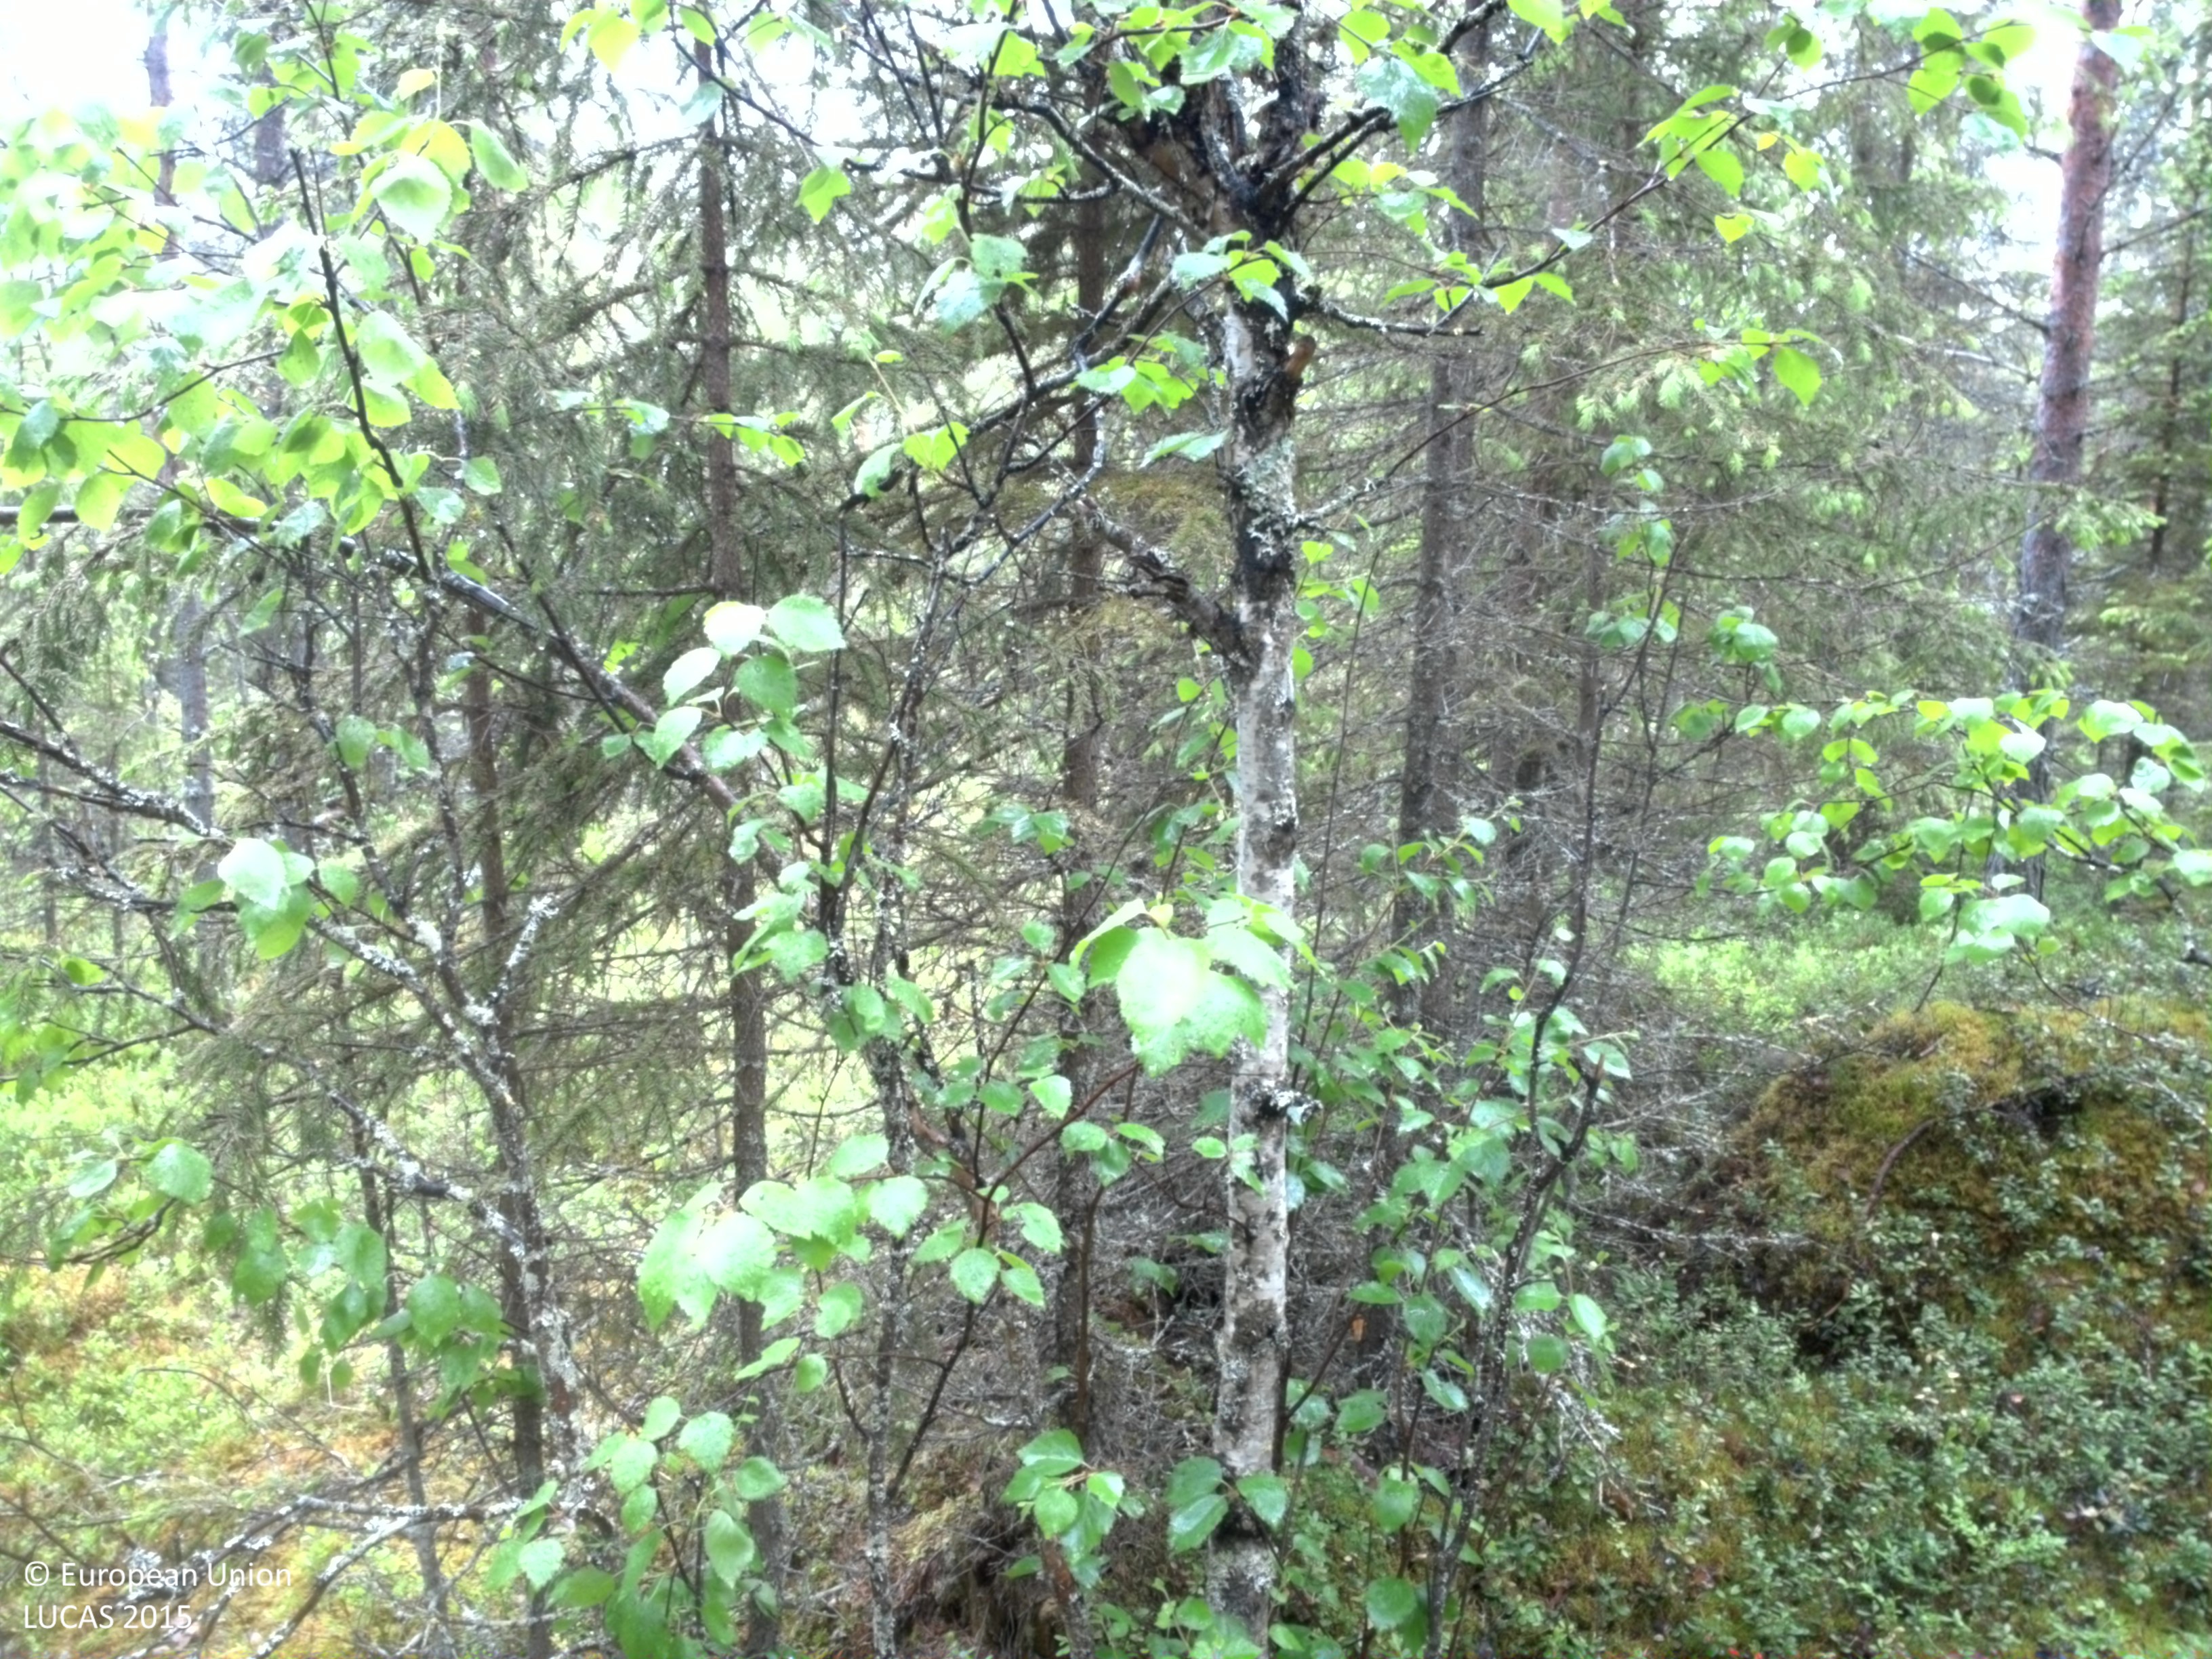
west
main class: Woodland
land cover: Pine dominated coniferous woodland
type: boreal forest
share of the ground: 25 - 50 %
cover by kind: shrubs 50 %, coniferous forest trees 40 %, broadleaved forest trees 5 %, lichens and mosses 5 %
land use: Forestry
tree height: > 5 m
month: June
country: SE
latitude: 66.5355
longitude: 22.8714
